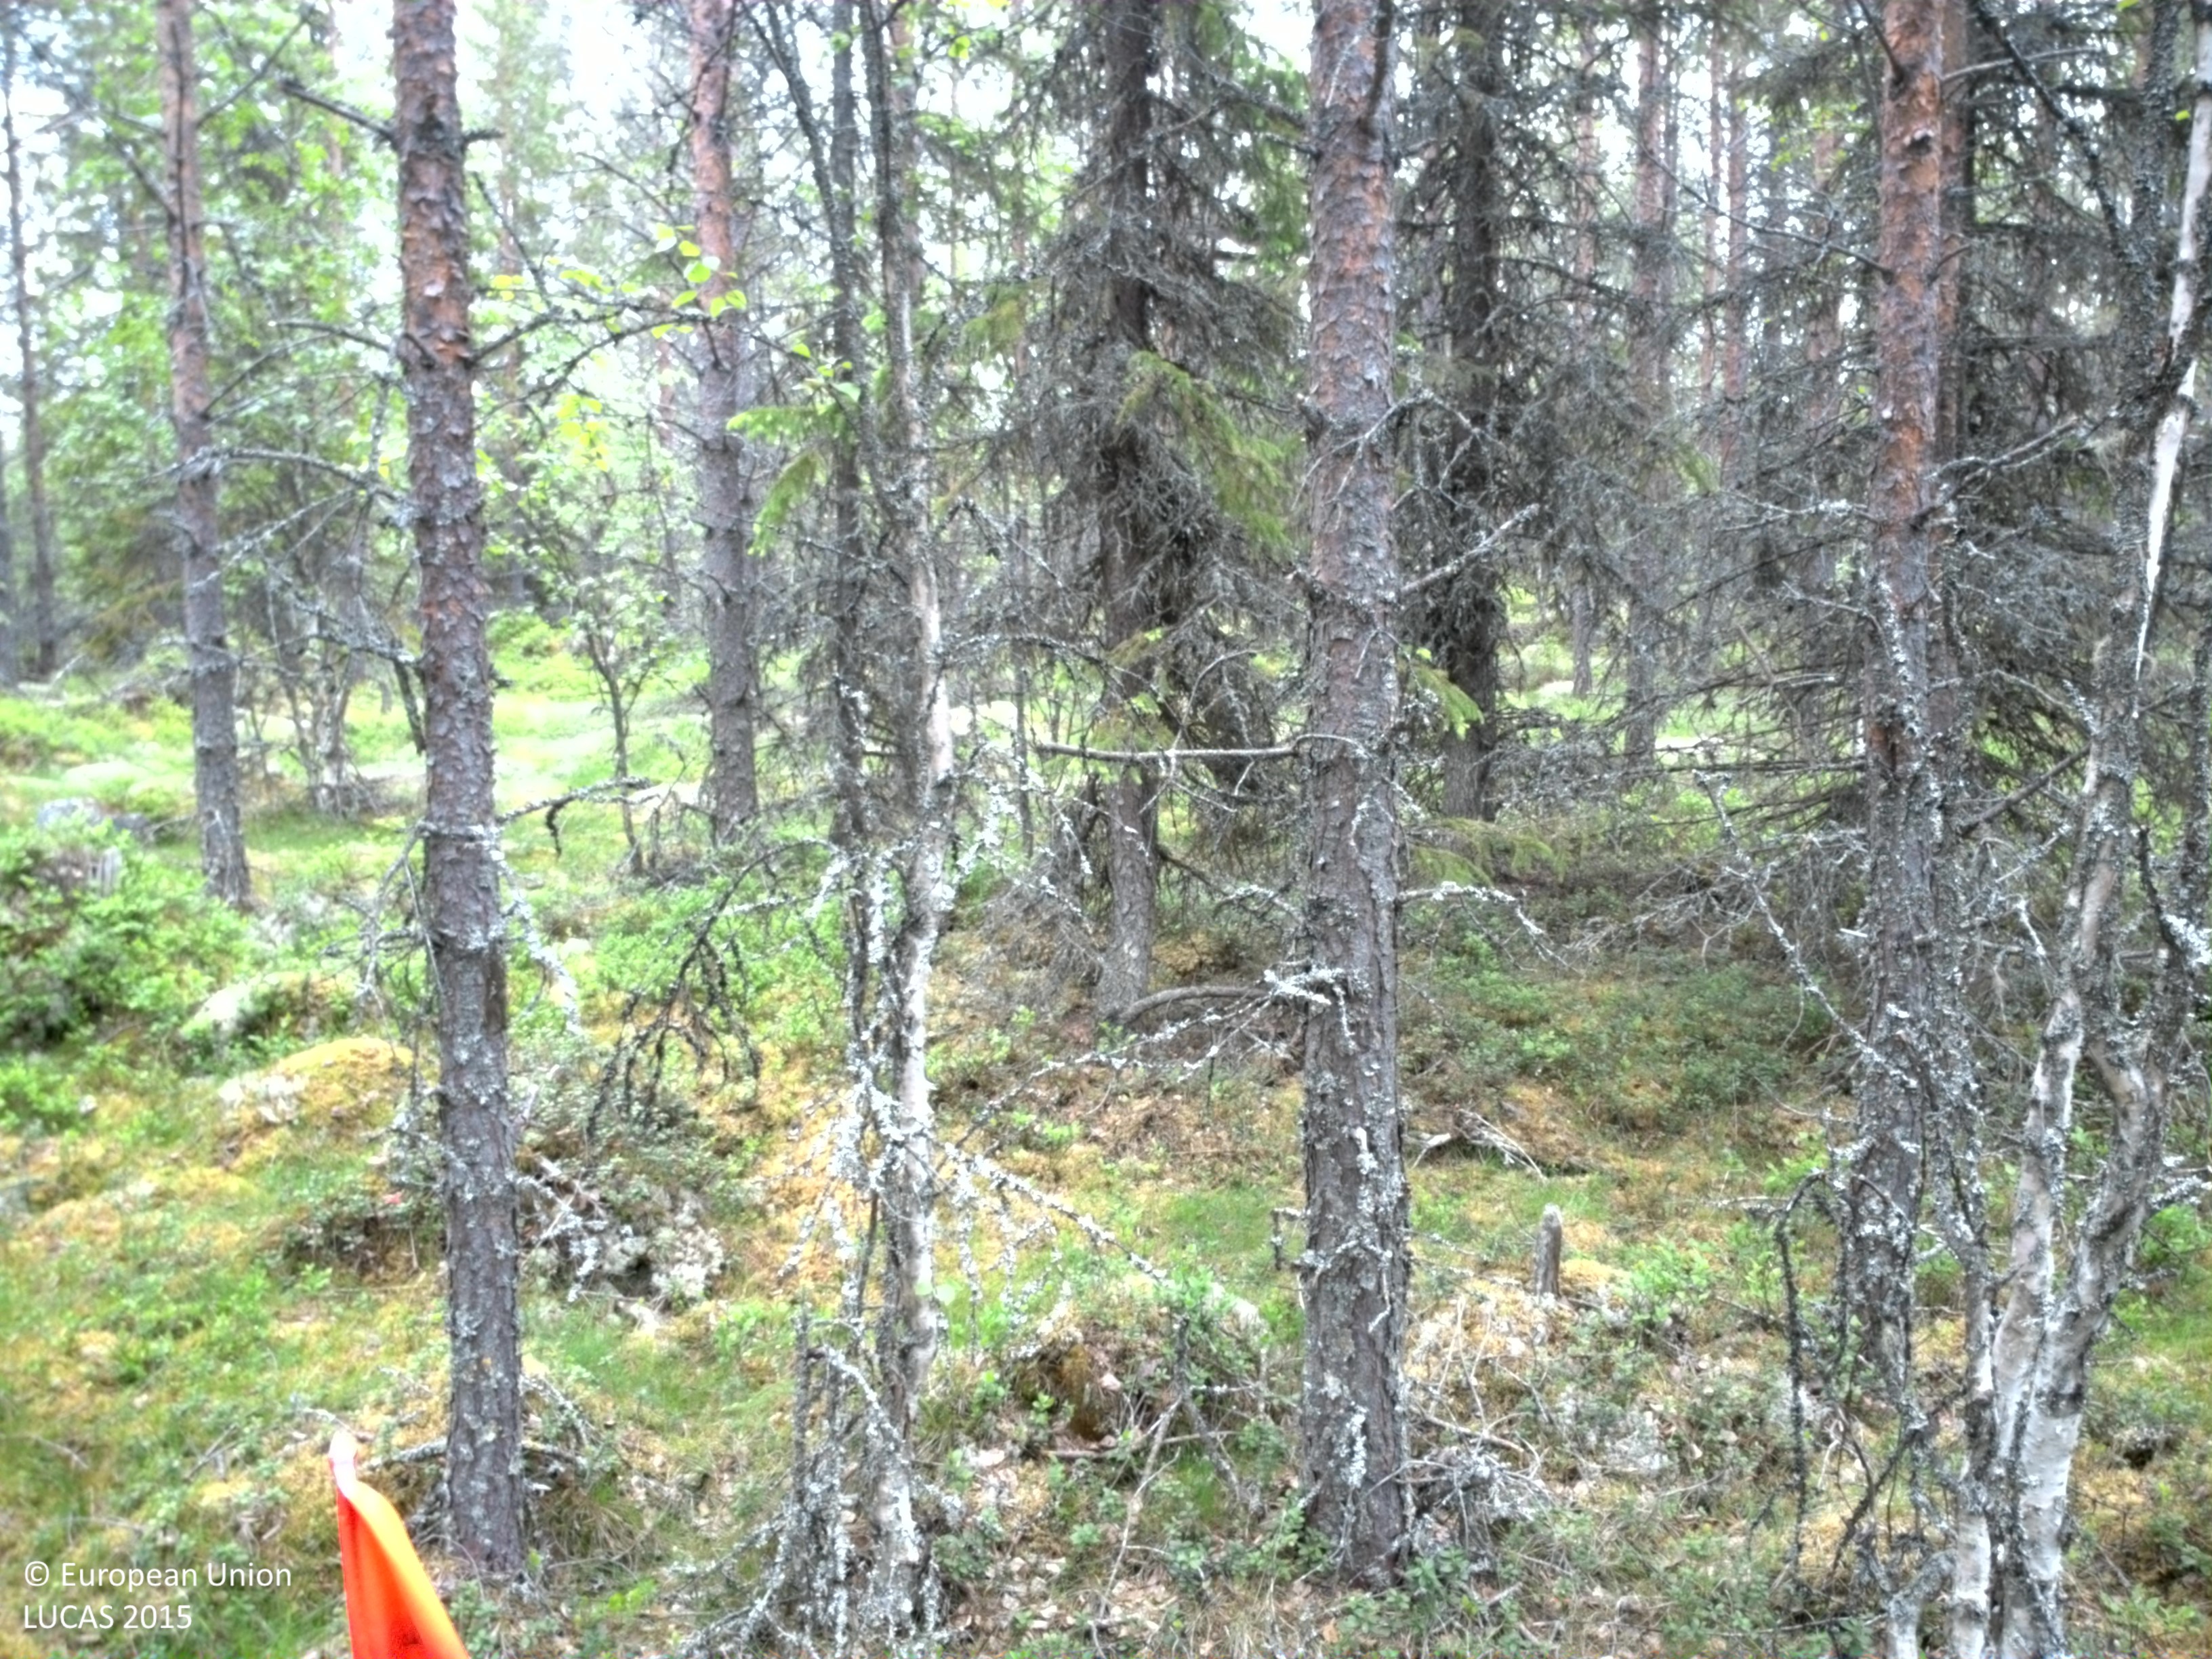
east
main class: Woodland
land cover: Pine dominated mixed woodland
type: boreal forest
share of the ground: 50 - 75 %
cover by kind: coniferous forest trees 50 %, broadleaved forest trees 25 %, lichens and mosses 15 %, herbaceous plants 10 %
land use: Forestry
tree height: > 5 m
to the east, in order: Pine dominated mixed woodland; Pine dominated coniferous woodland; Peatbogs; Pine dominated coniferous woodland
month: June
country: SE
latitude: 61.1610
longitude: 13.6490
